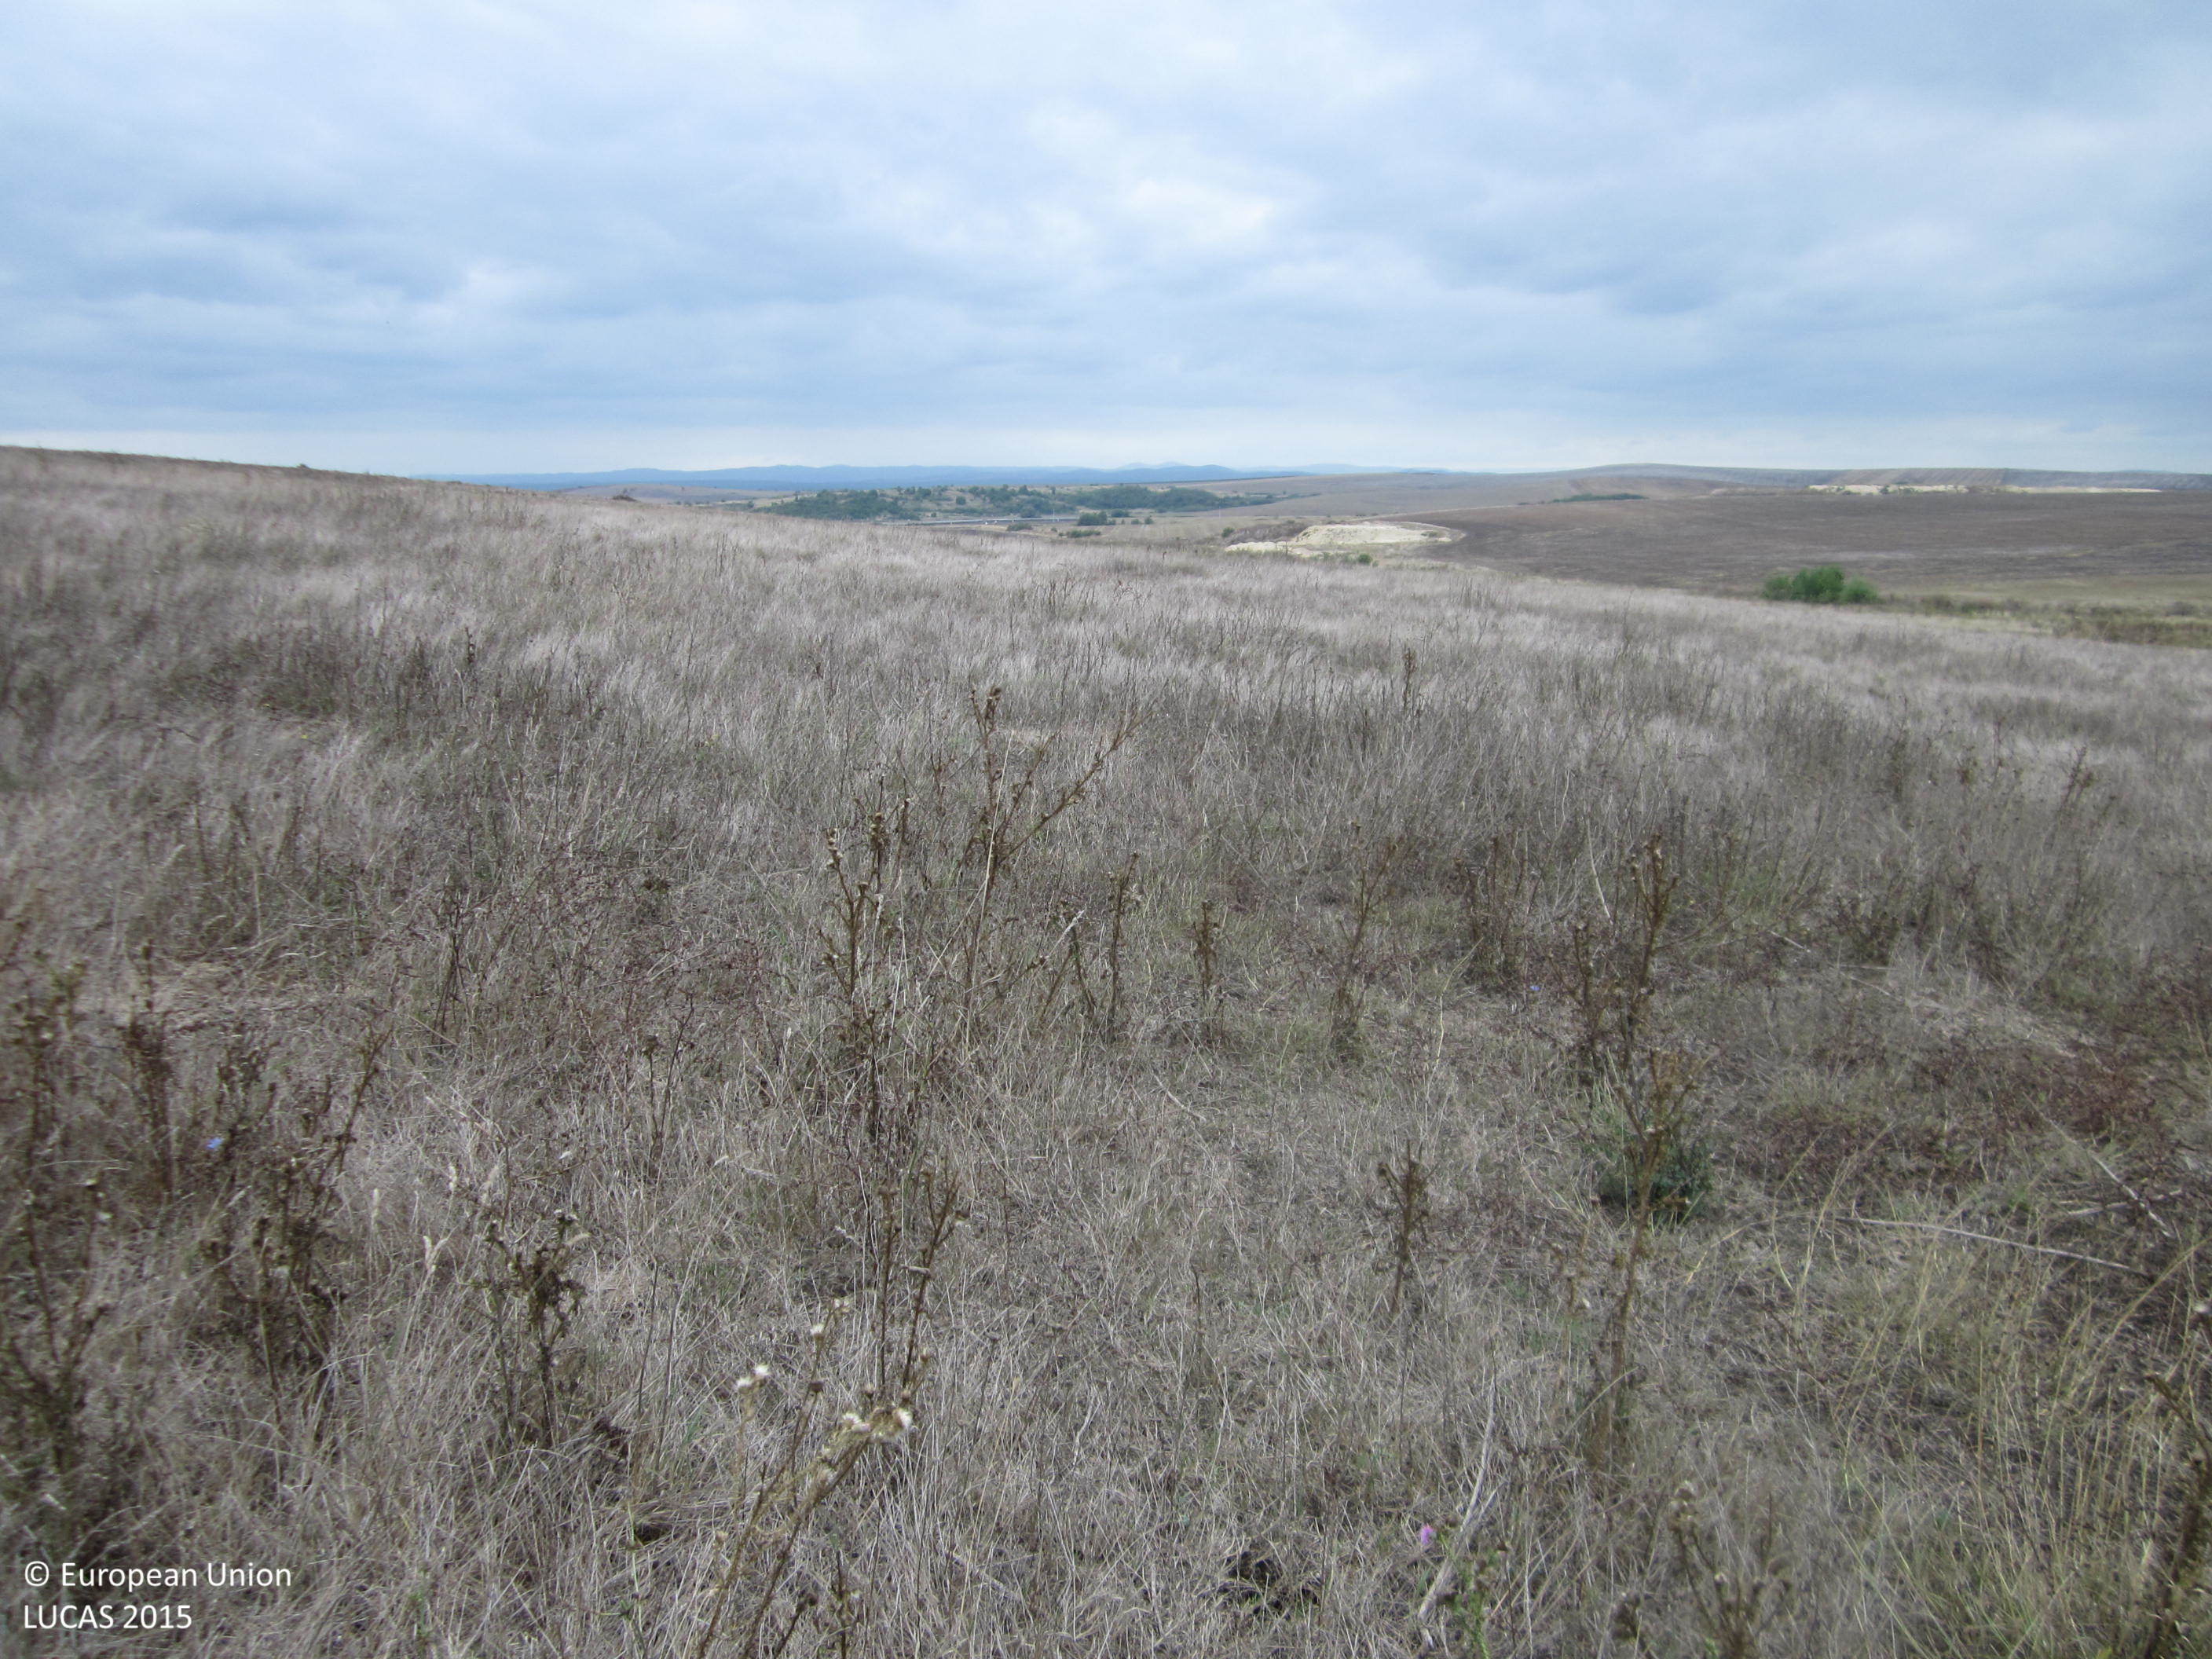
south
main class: Grassland
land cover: Grassland without tree/shrub cover
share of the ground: > 75 %
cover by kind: herbaceous plants 100 %
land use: Agriculture (excluding fallow land and kitchen gardens)
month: September
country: BG
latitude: 42.4569
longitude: 27.3190
